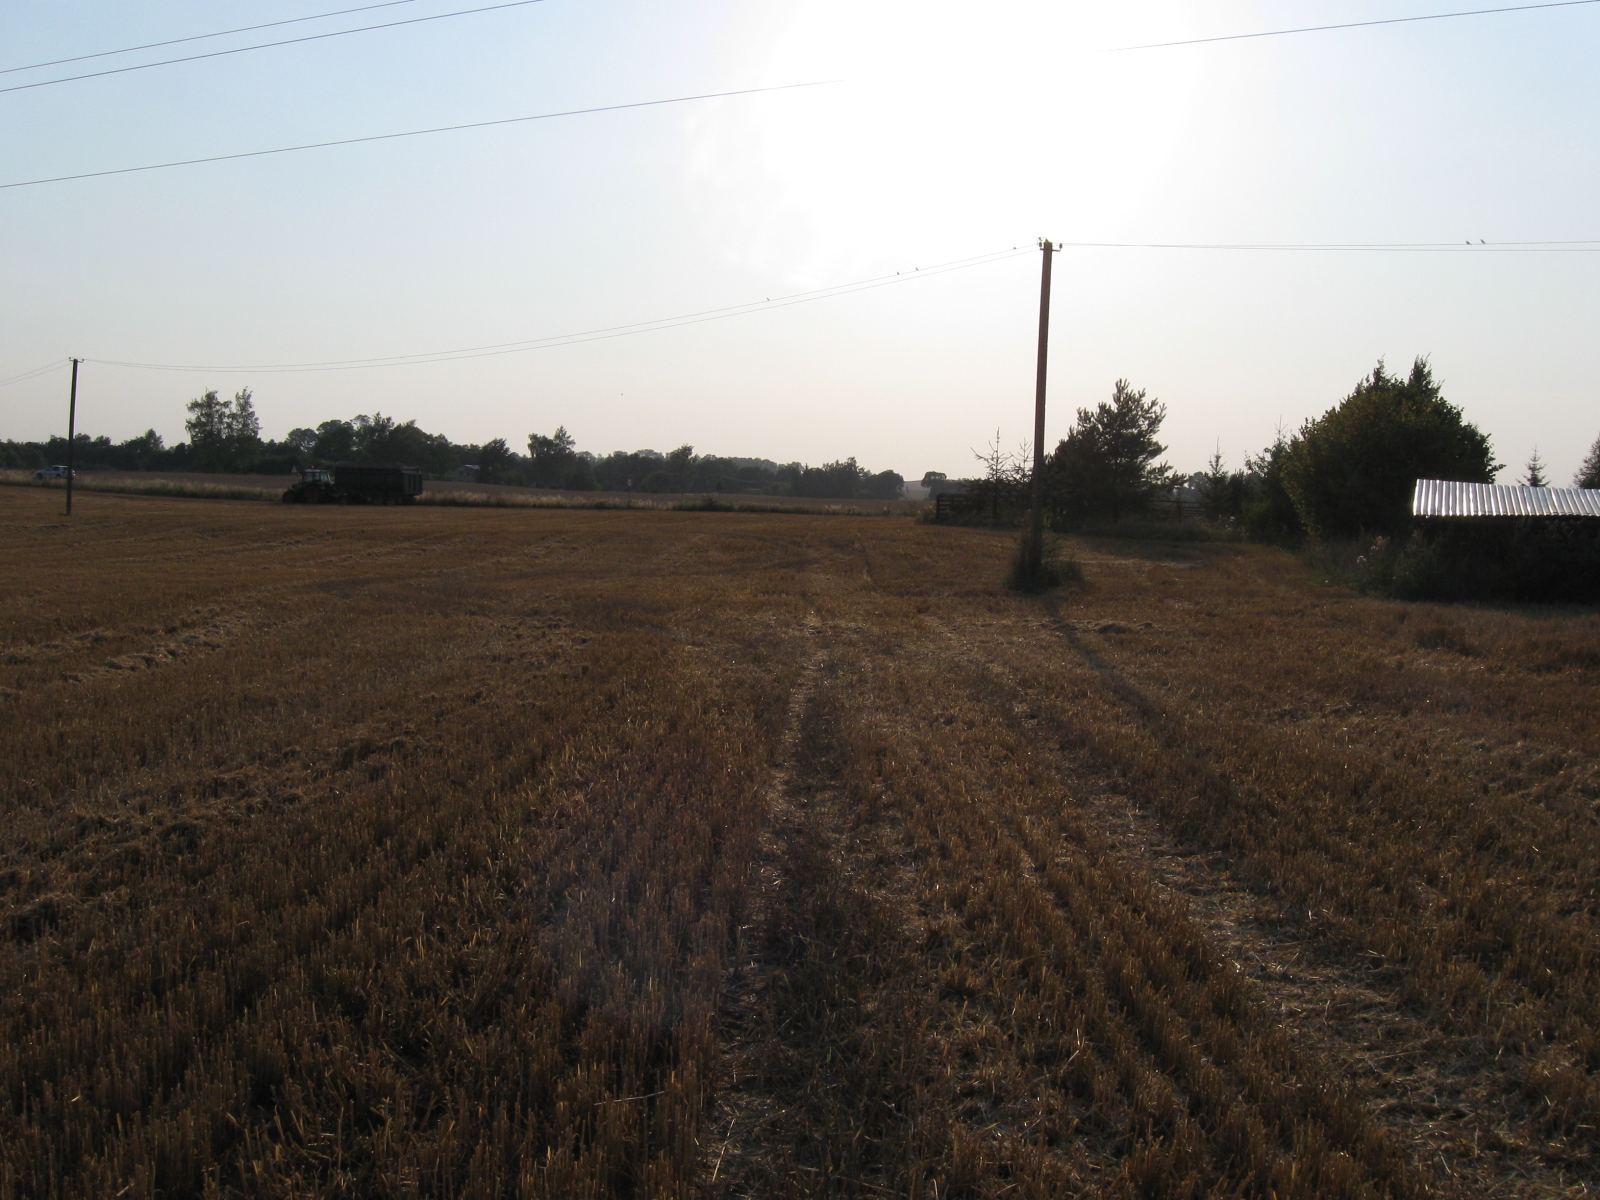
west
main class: Cropland
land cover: Common wheat
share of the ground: < 10 %
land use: Agriculture (excluding fallow land and kitchen gardens)
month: August
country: LT
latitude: 54.4727
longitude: 23.2711
